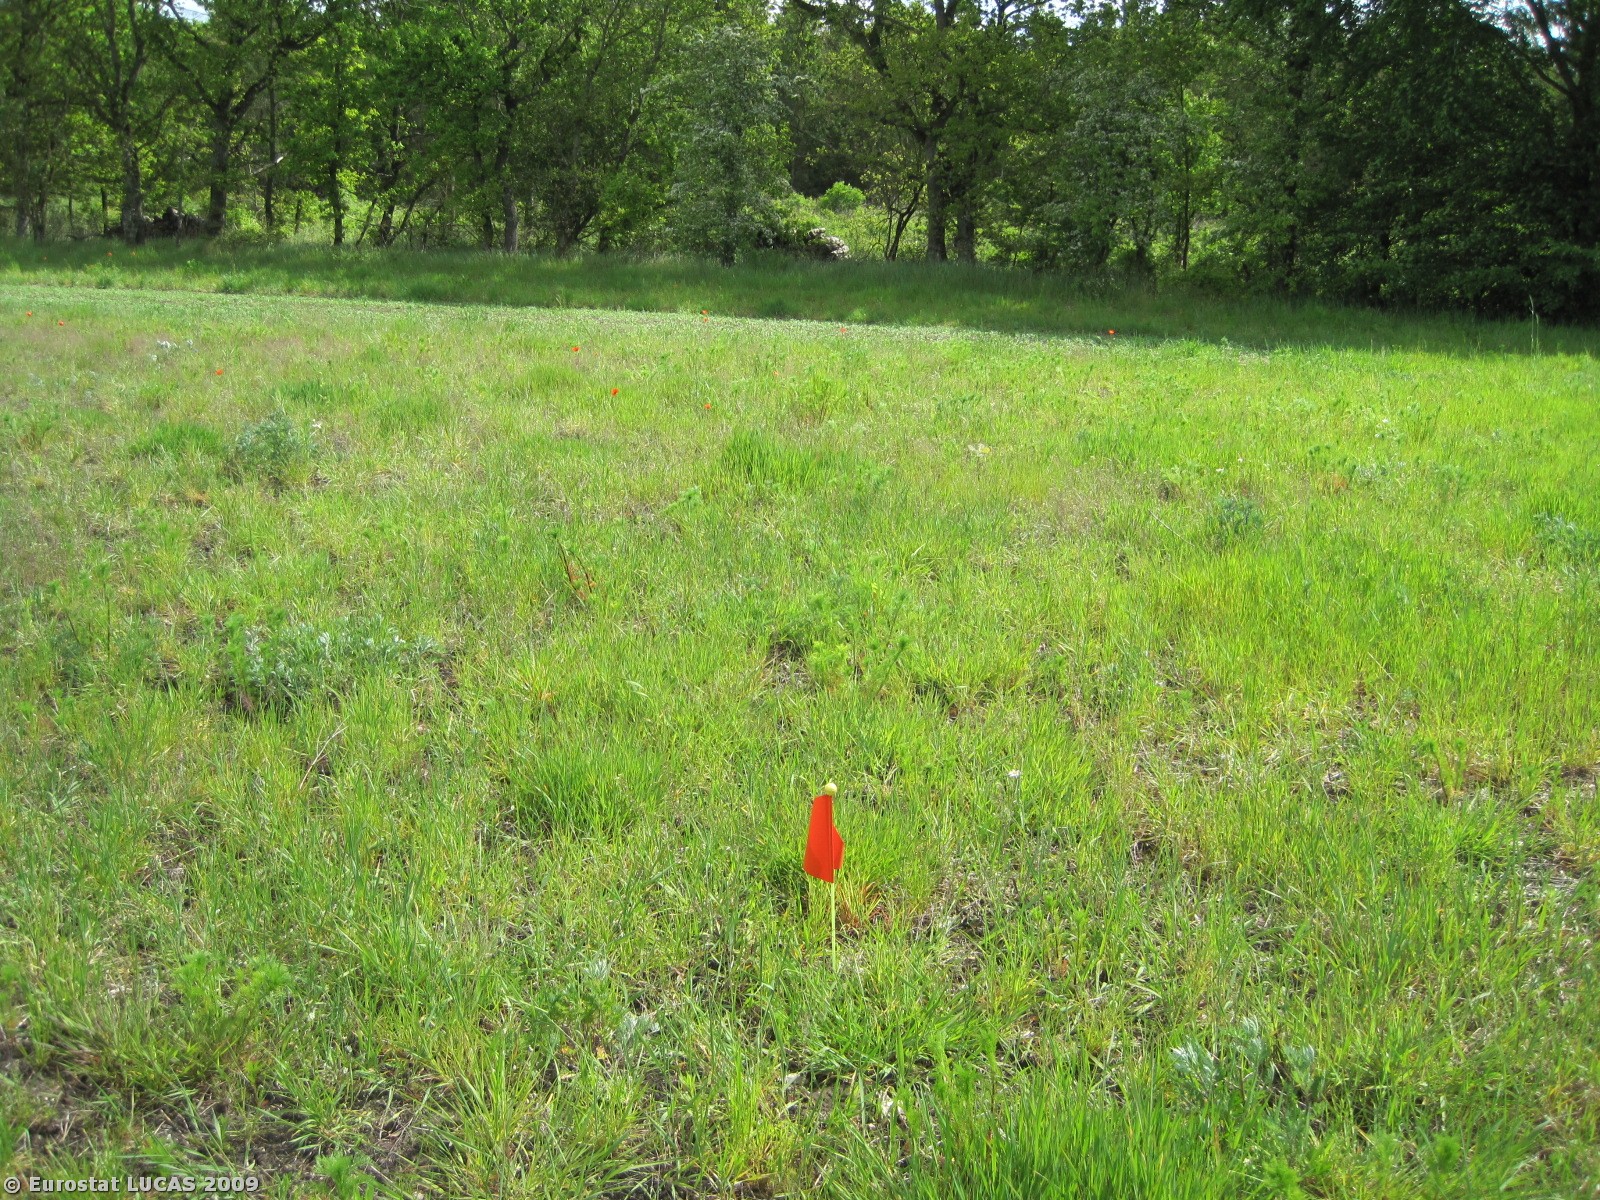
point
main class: Grassland
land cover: Grassland without tree/shrub cover
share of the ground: > 75 %
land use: Agriculture (excluding fallow land and kitchen gardens)
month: May
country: DK
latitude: 56.5471
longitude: 9.7888
